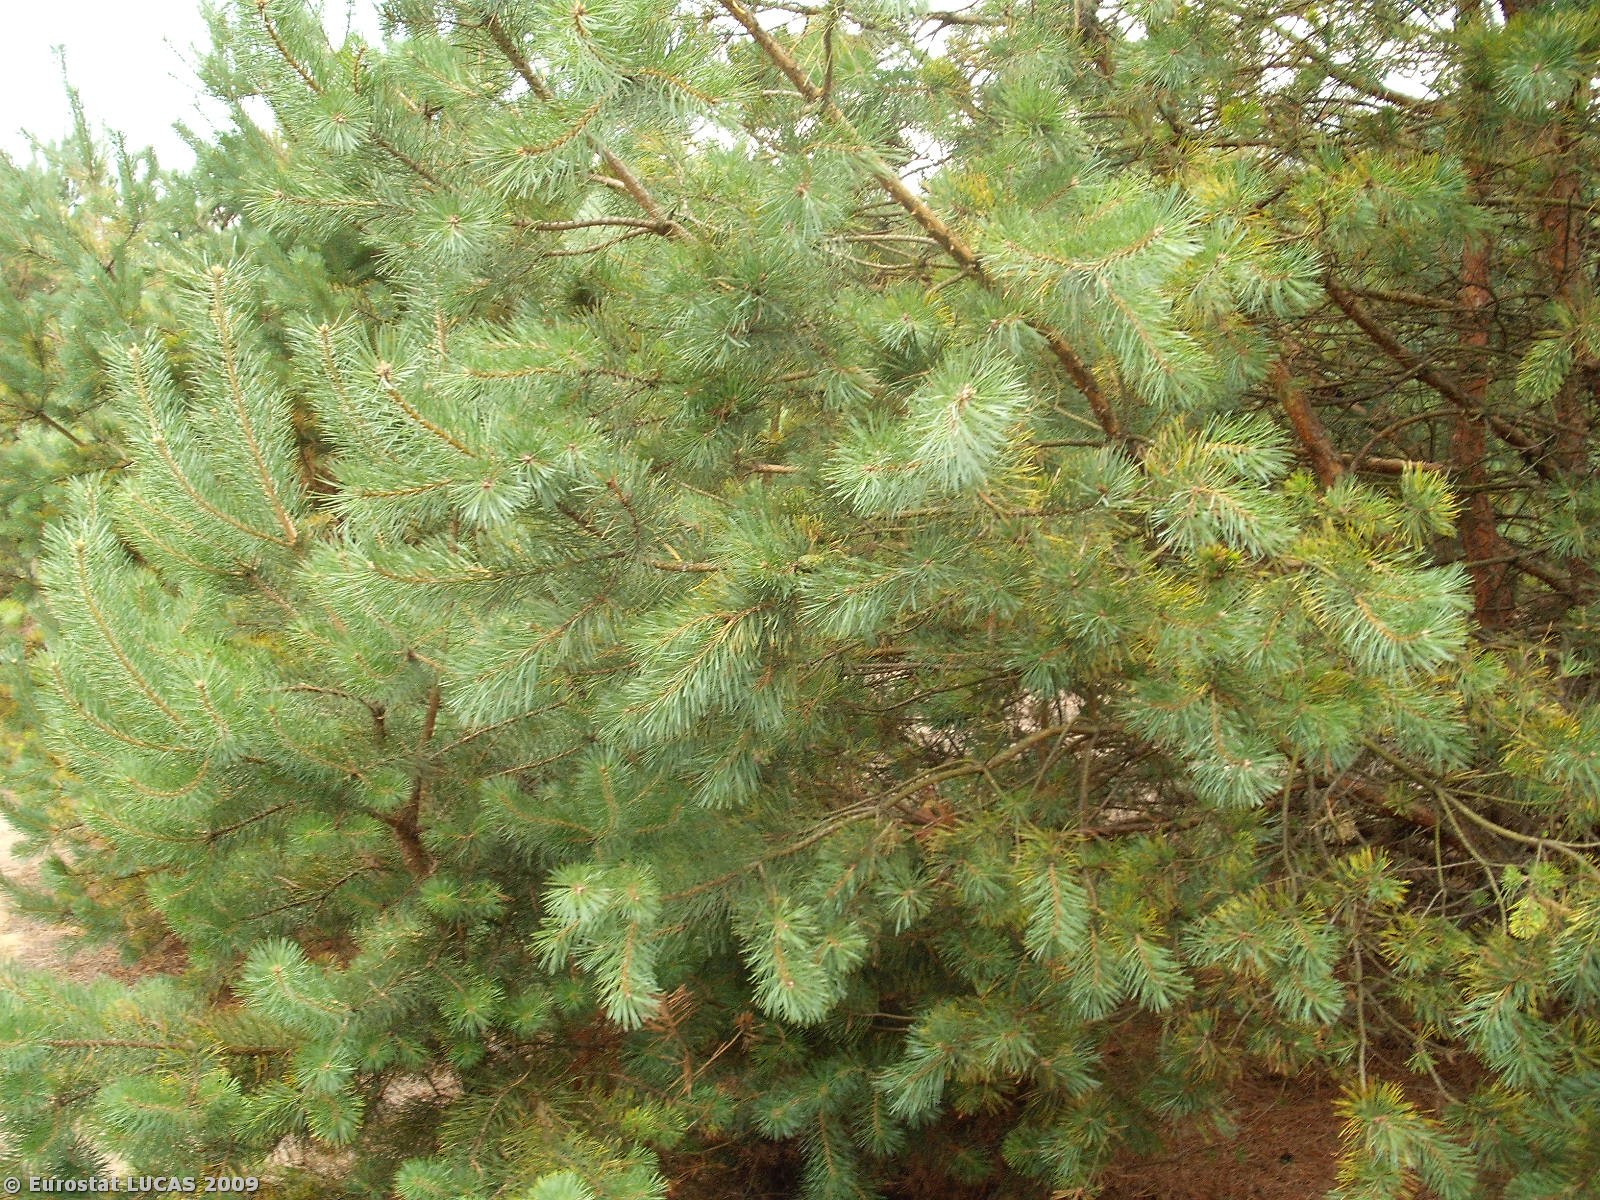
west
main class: Woodland
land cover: Coniferous woodland
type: hemiboreal forest and nemoral coniferous forest and mixed broadleaved-coniferous forest
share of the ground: 50 - 75 %
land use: Forestry
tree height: > 5 m
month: July
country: PL
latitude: 51.3858
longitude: 21.4455
